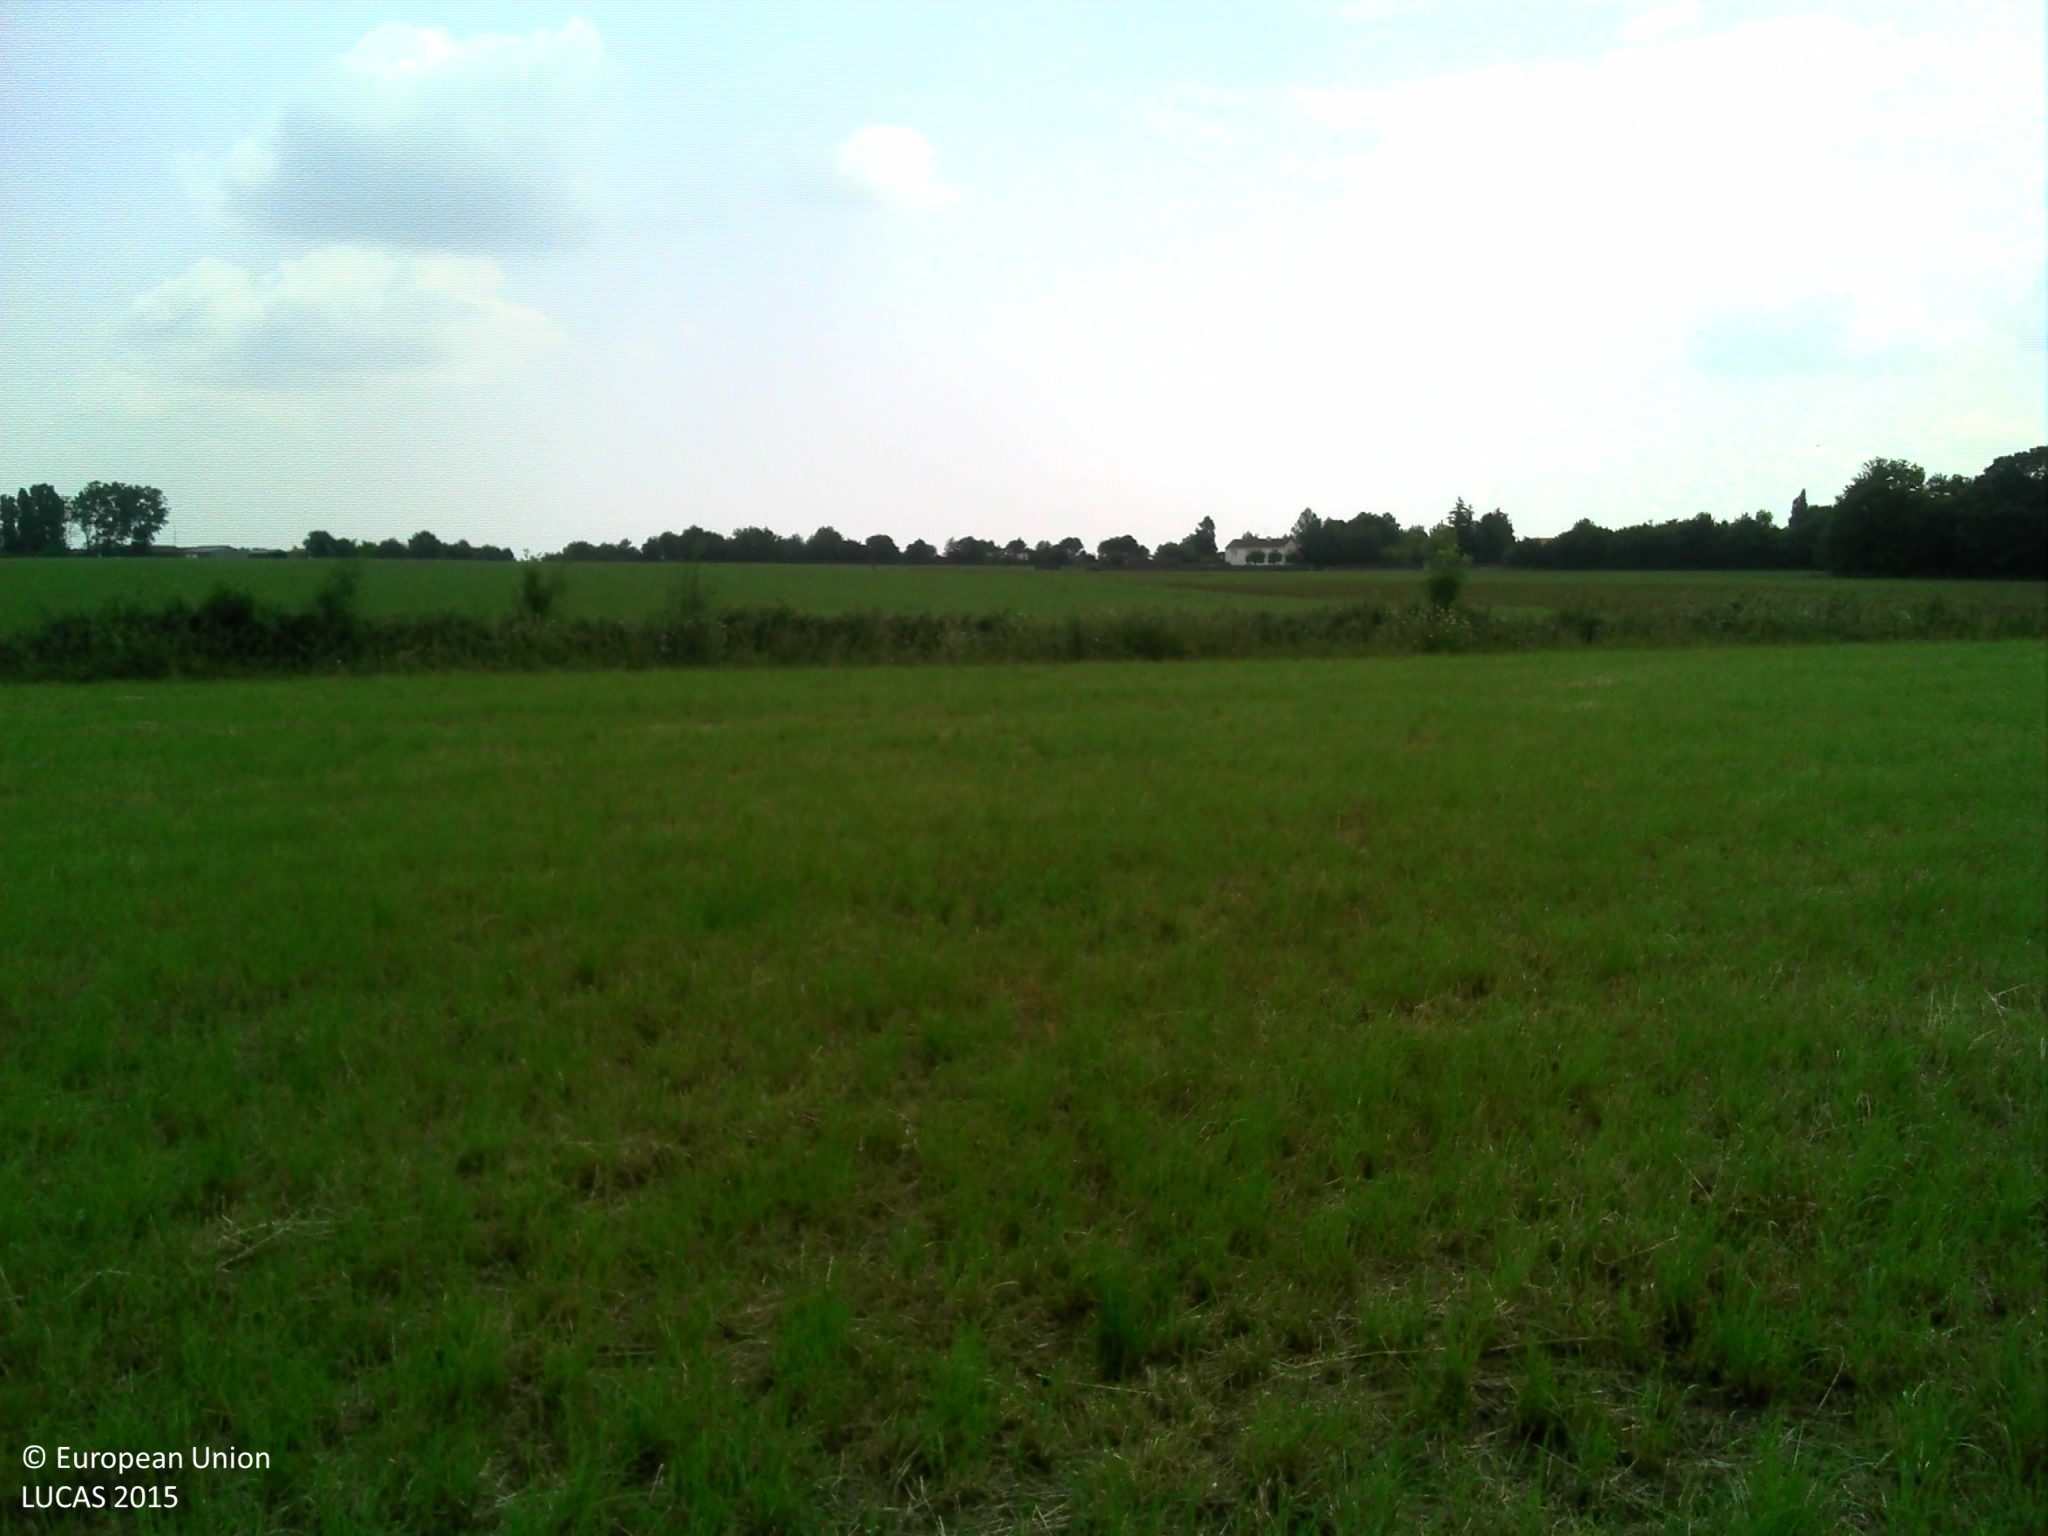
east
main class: Cropland
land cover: Temporary grasslands
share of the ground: > 75 %
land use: Agriculture (excluding fallow land and kitchen gardens)
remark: Harvested field
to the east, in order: Temporary grasslands; Ditches and canals; Shruby margins; Temporary grasslands; Maize
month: June
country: FR
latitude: 46.9243
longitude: -1.3718
